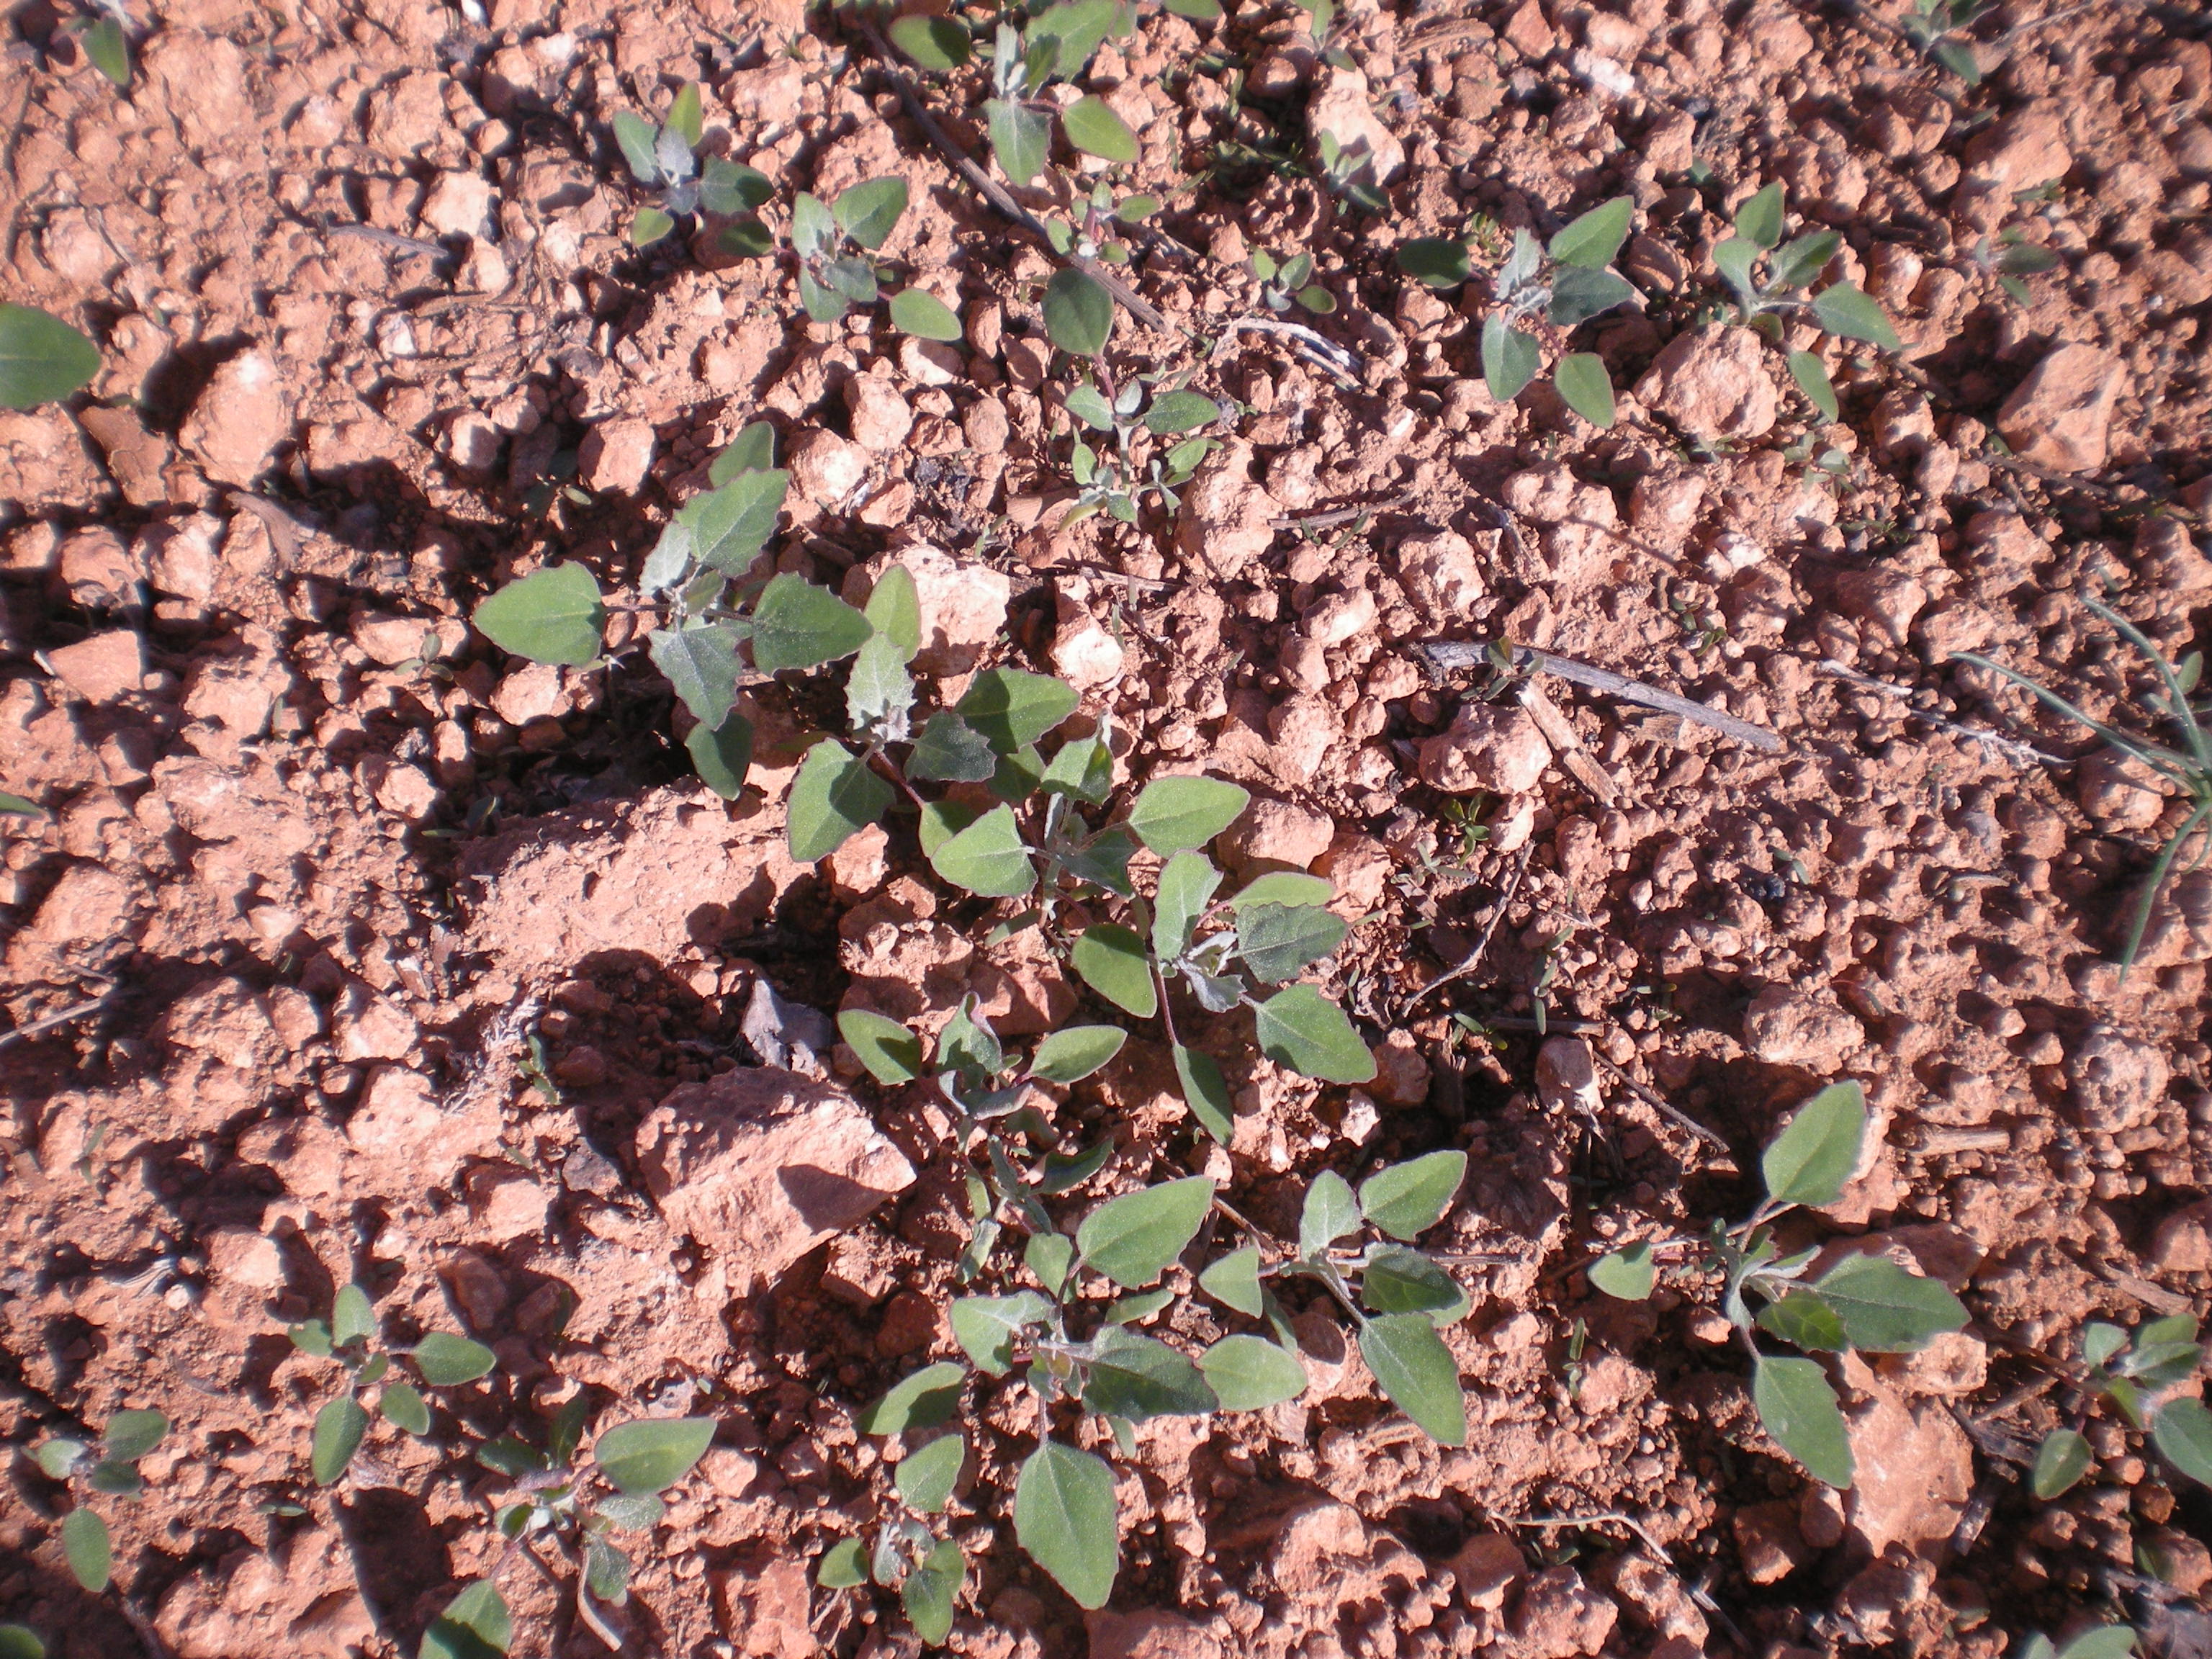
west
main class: Cropland
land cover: Vineyards
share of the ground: < 10 %
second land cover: Other bare soil
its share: > 75 %
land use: Agriculture (excluding fallow land and kitchen gardens)
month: April
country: ES
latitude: 38.7863
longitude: -3.1907
